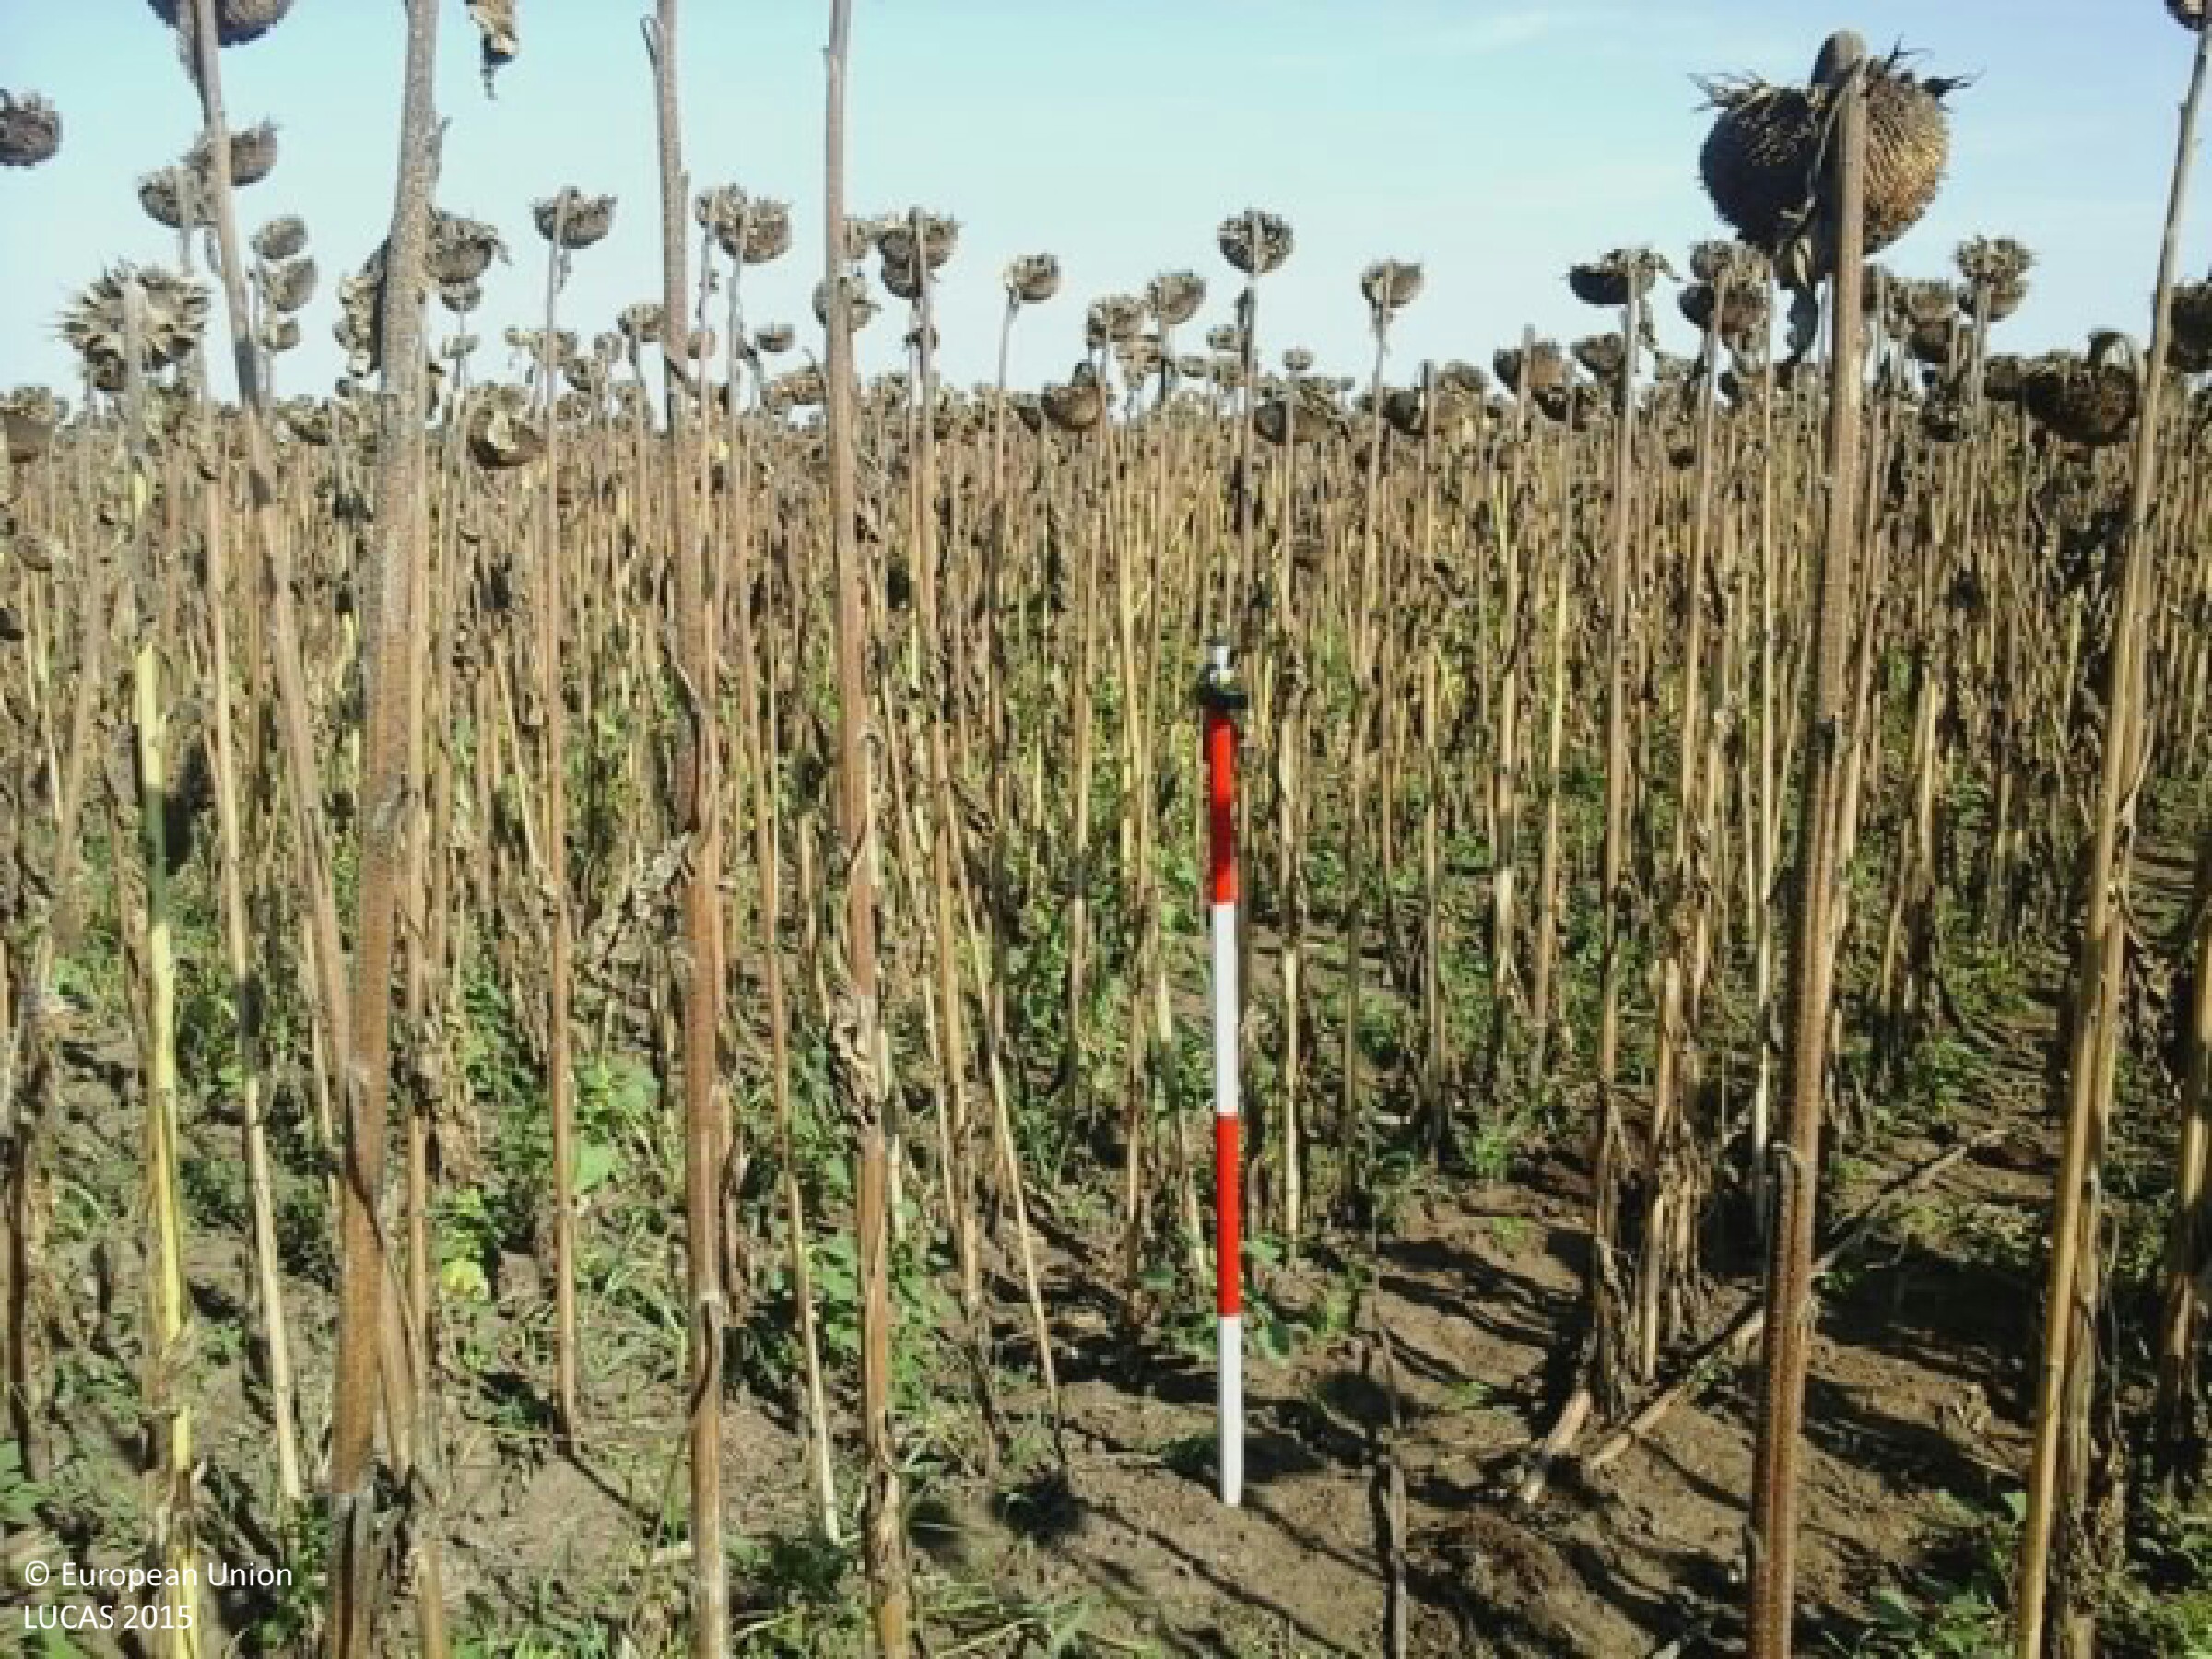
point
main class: Cropland
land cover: Sunflower
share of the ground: > 75 %
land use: Agriculture (excluding fallow land and kitchen gardens)
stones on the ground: < 10 %
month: September
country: HU
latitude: 47.6426
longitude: 19.7816
